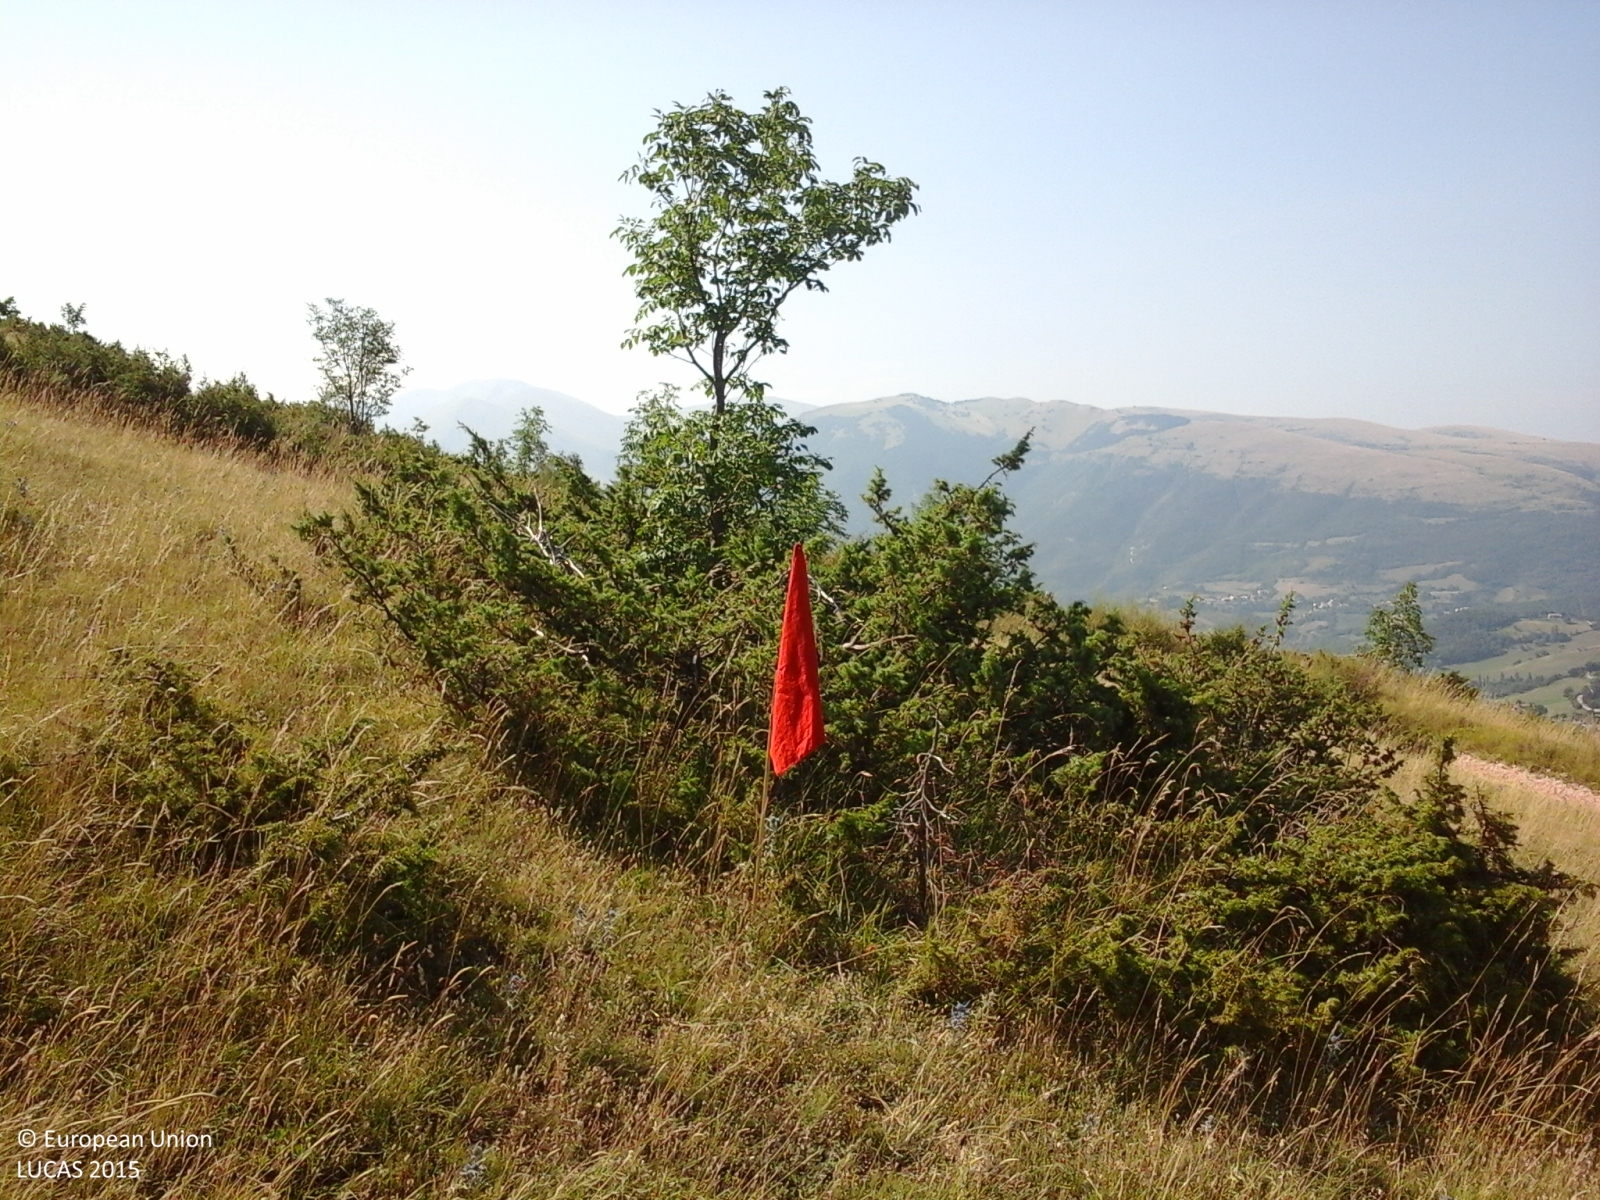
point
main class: Shrubland
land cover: Shrubland with sparse tree cover
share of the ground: > 75 %
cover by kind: herbaceous plants 60 %, shrubs 35 %, coniferous forest trees 5 %
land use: Agriculture (excluding fallow land and kitchen gardens)
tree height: < 5 m
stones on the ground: > 50 %
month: August
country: IT
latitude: 43.0742
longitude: 13.1721
